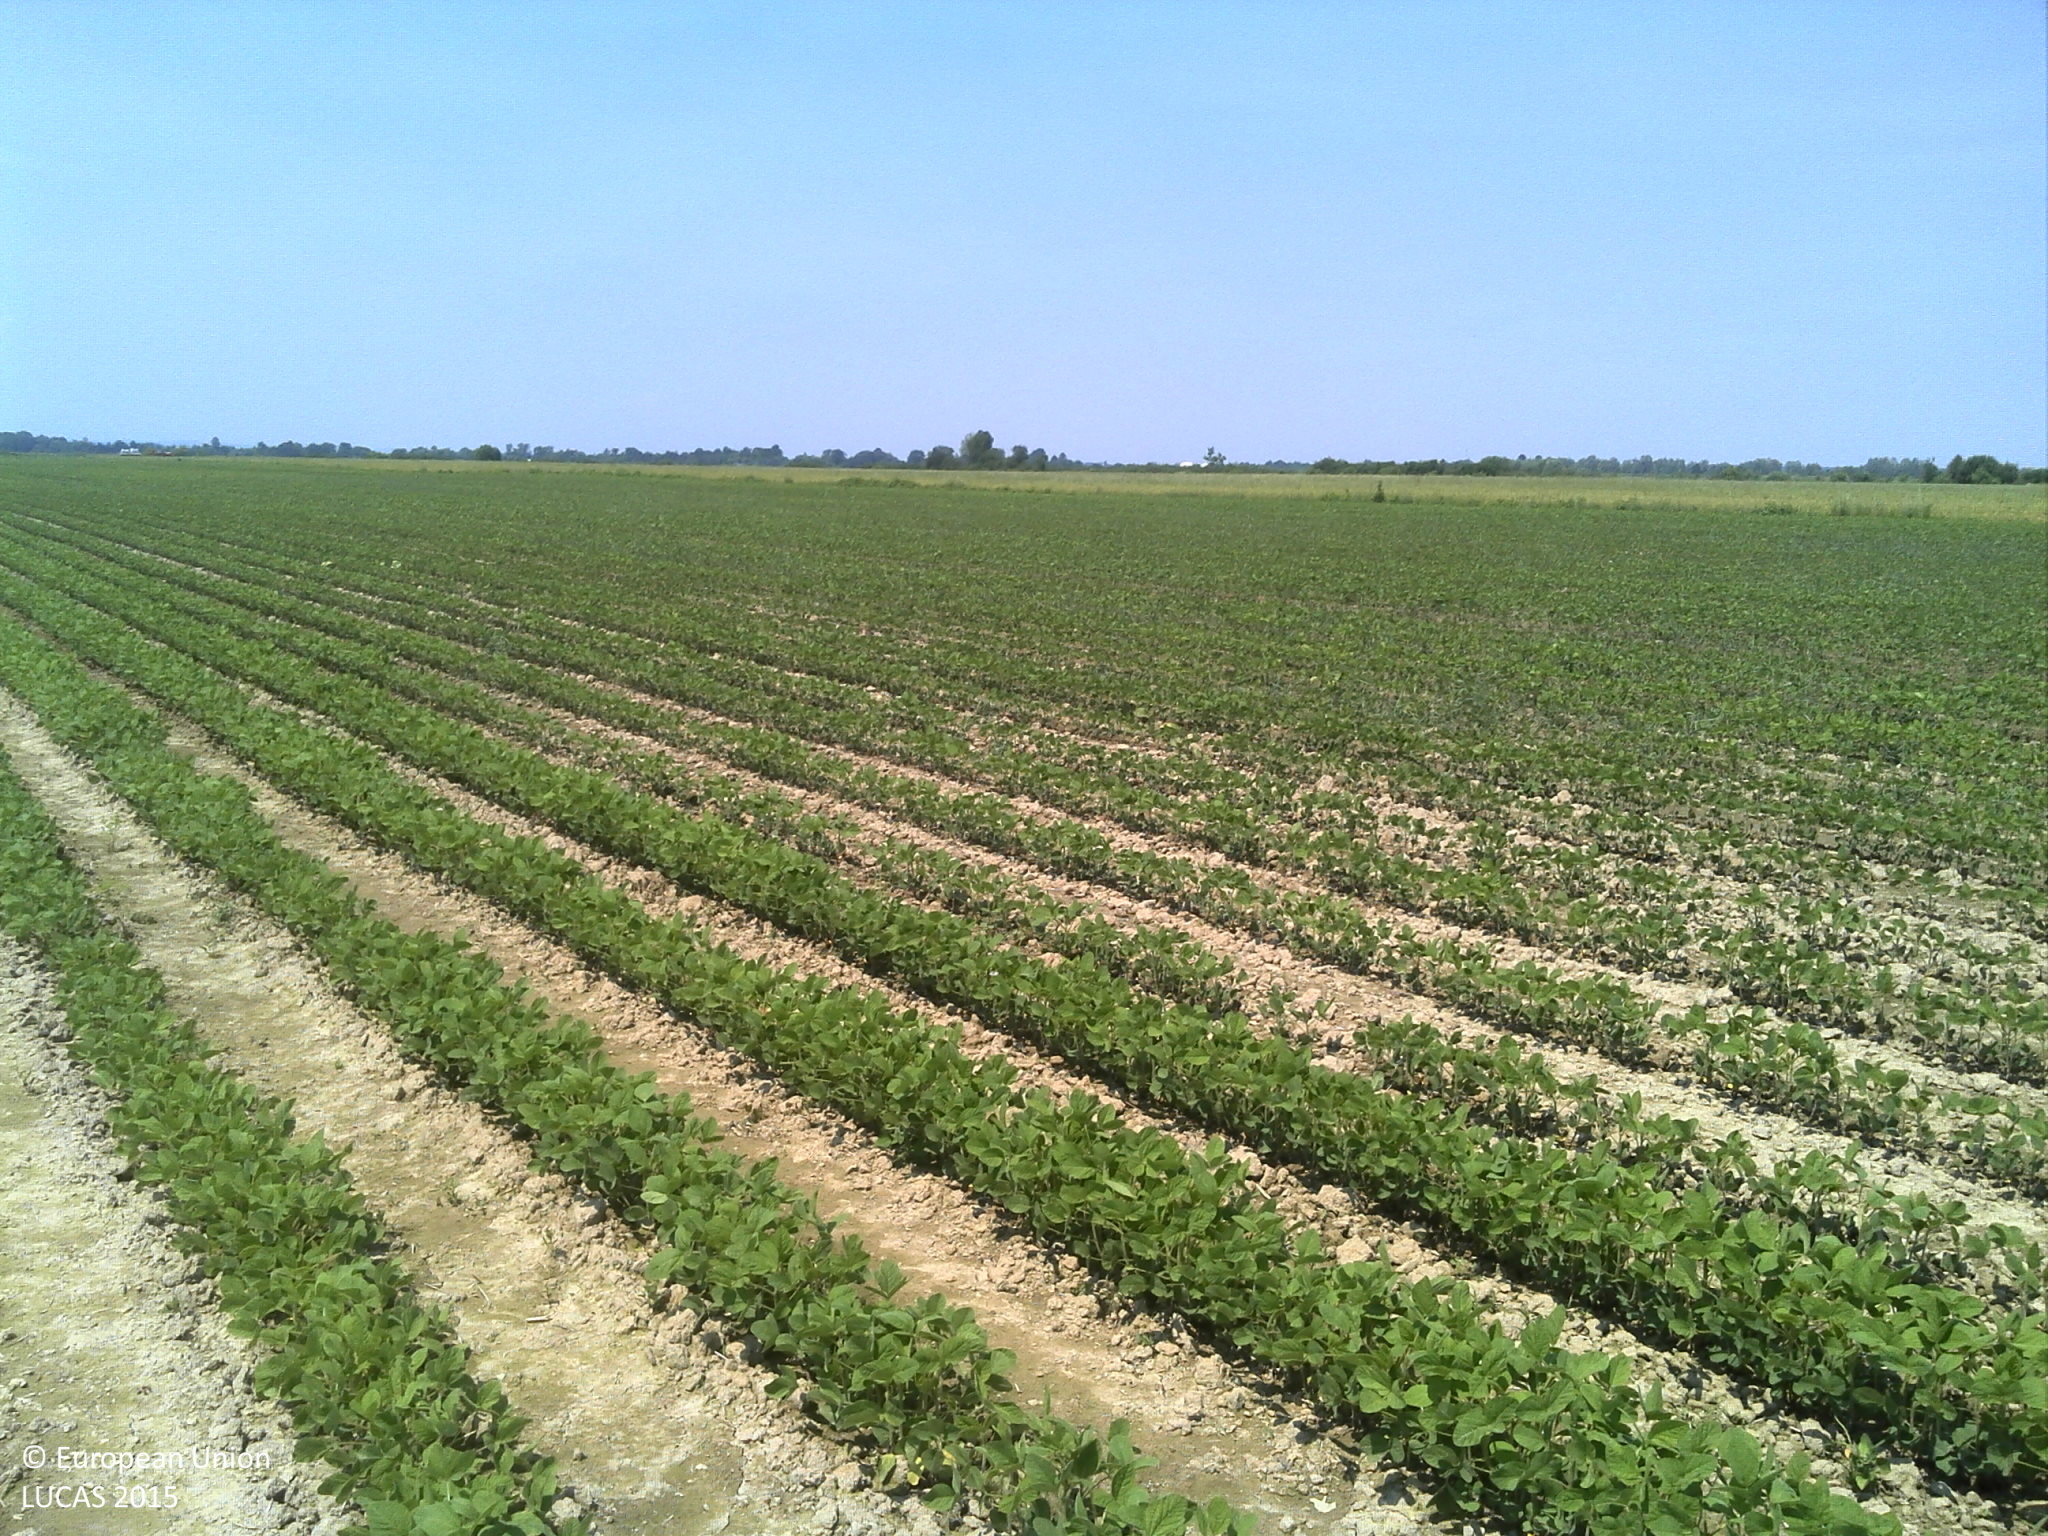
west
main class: Cropland
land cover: Soya
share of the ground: 10 - 25 %
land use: Agriculture (excluding fallow land and kitchen gardens)
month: June
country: HR
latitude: 45.6730
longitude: 17.9761
